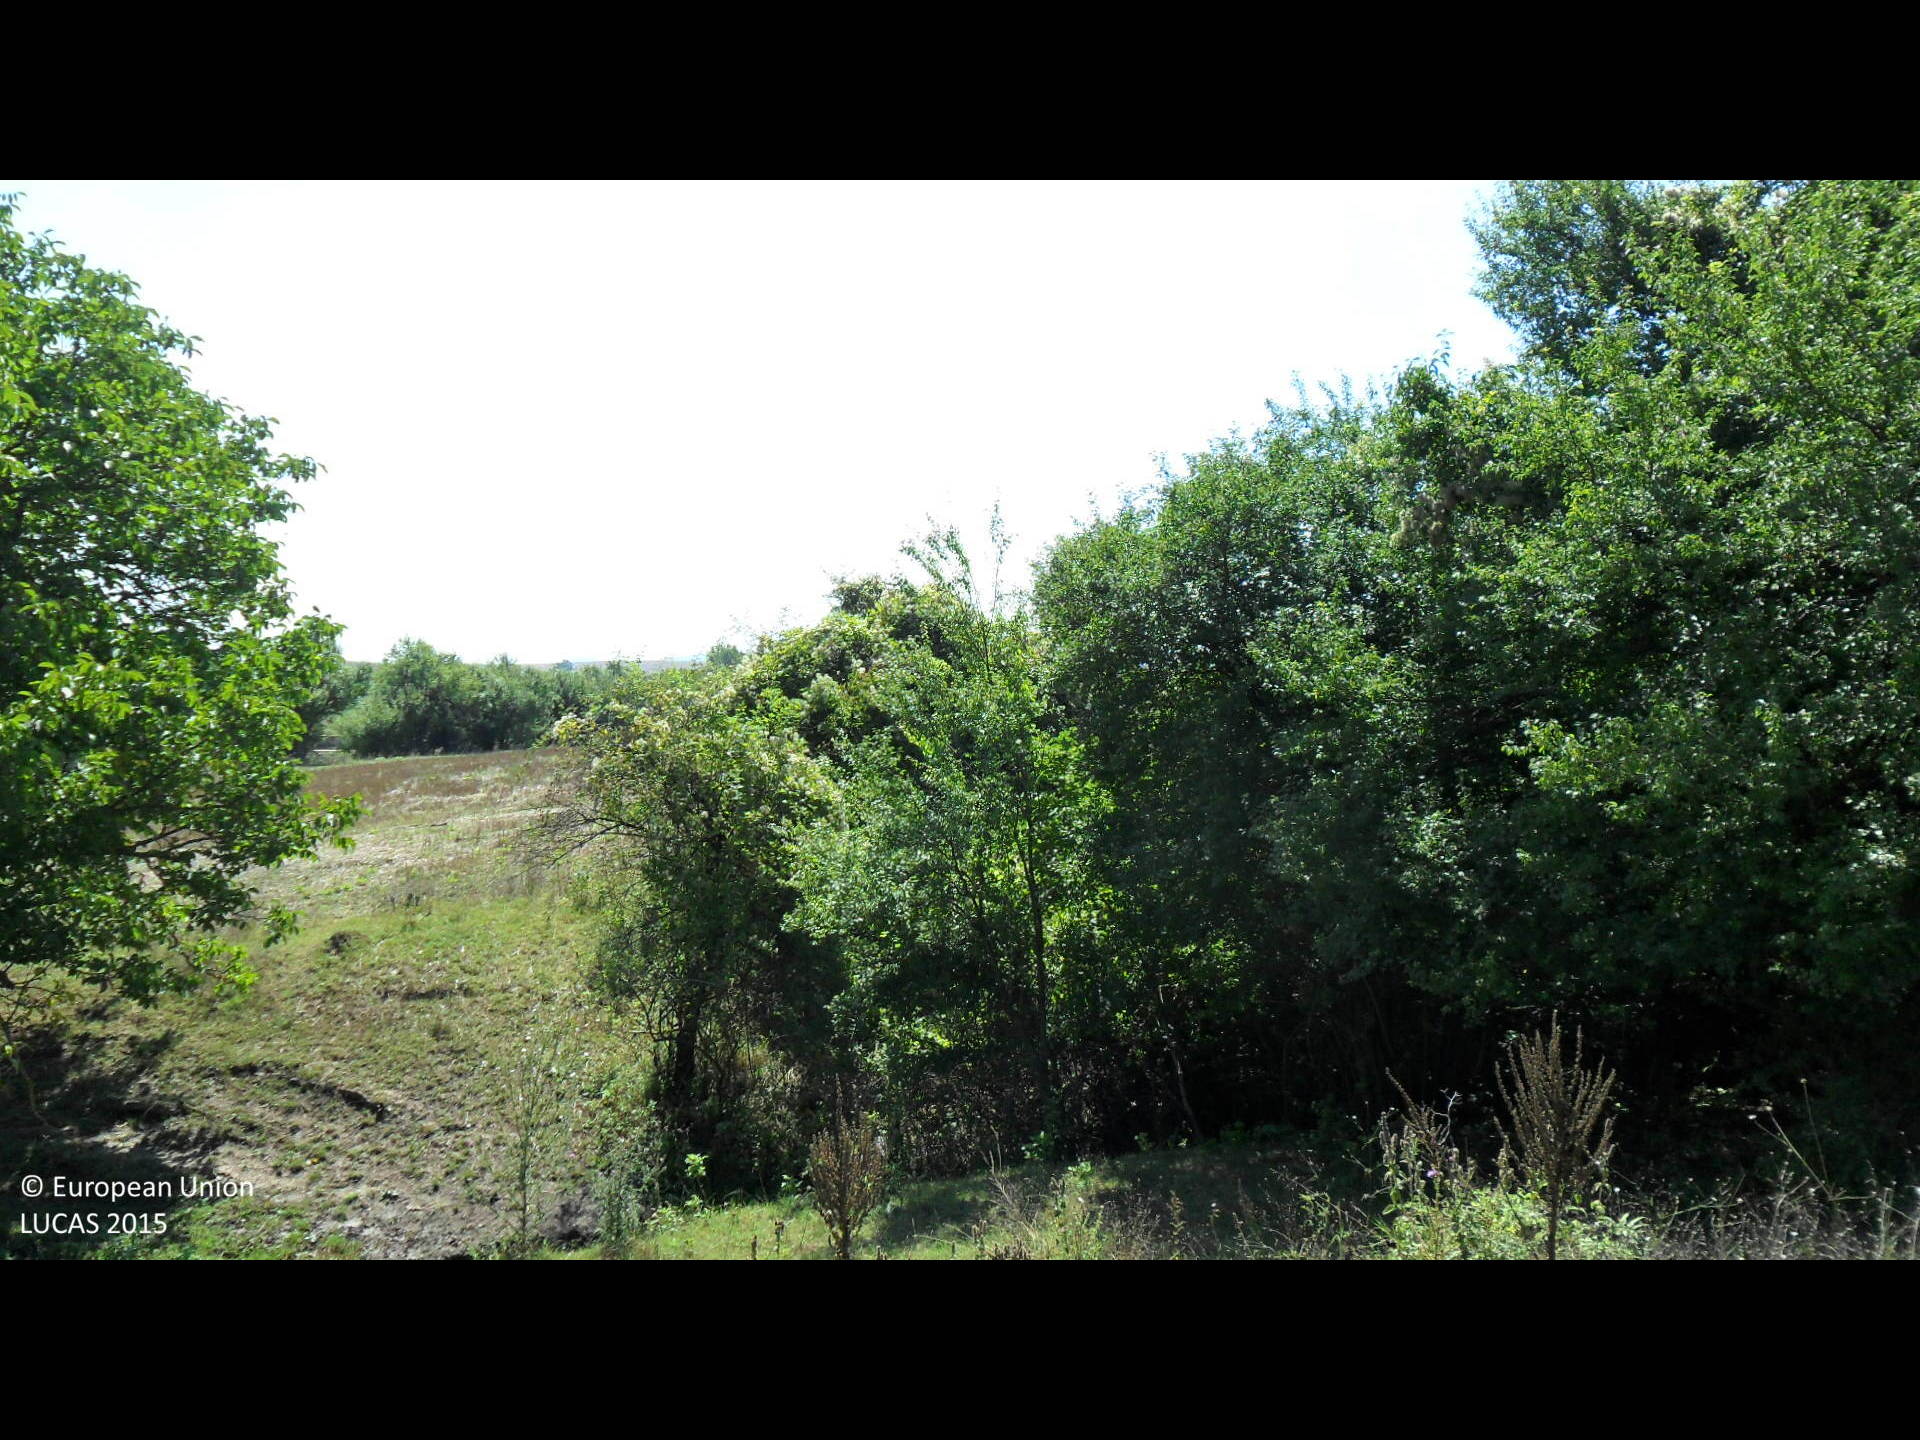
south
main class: Grassland
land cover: Grassland without tree/shrub cover
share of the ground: > 75 %
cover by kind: herbaceous plants 100 %
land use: Agriculture (excluding fallow land and kitchen gardens)
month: August
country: BG
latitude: 43.4377
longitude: 26.2961
